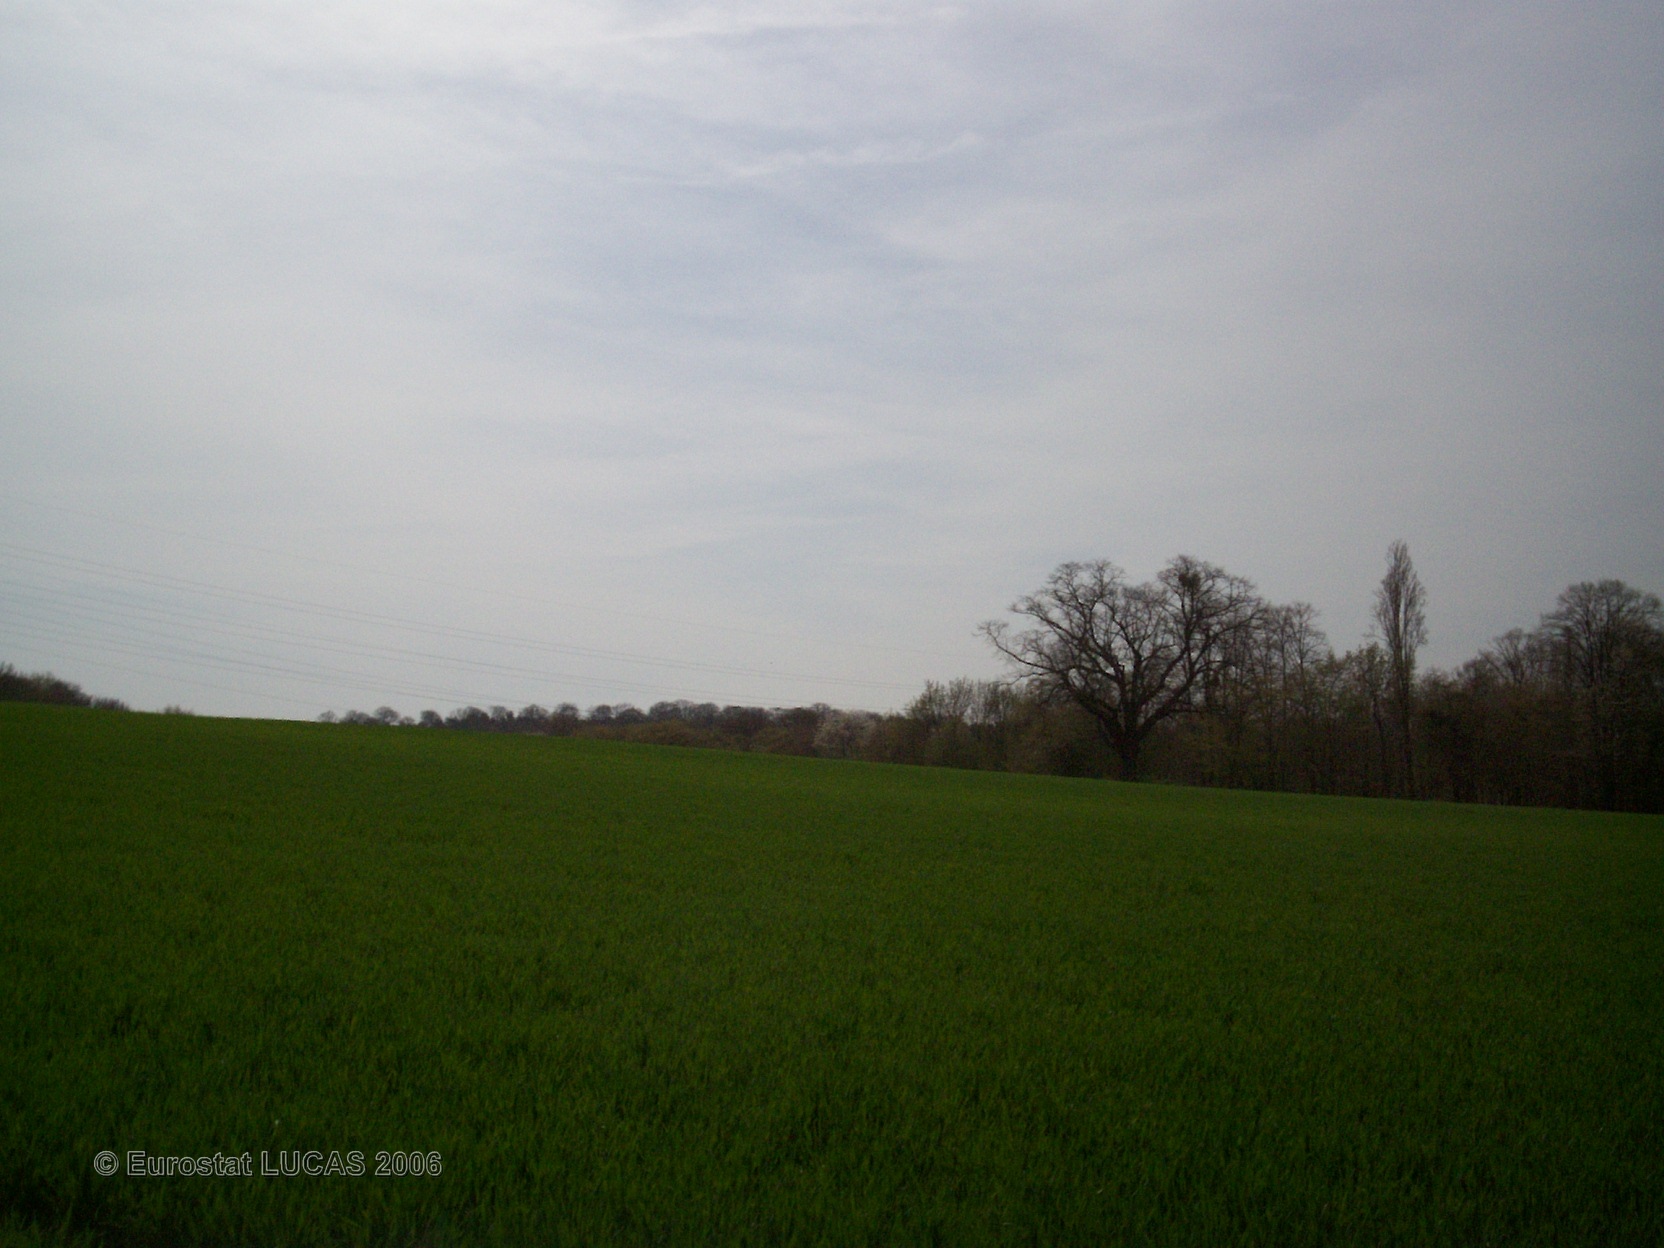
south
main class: Cropland
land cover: Common wheat
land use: Agriculture (excluding fallow land and kitchen gardens)
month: April
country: FR
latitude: 49.4075
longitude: 0.9502
